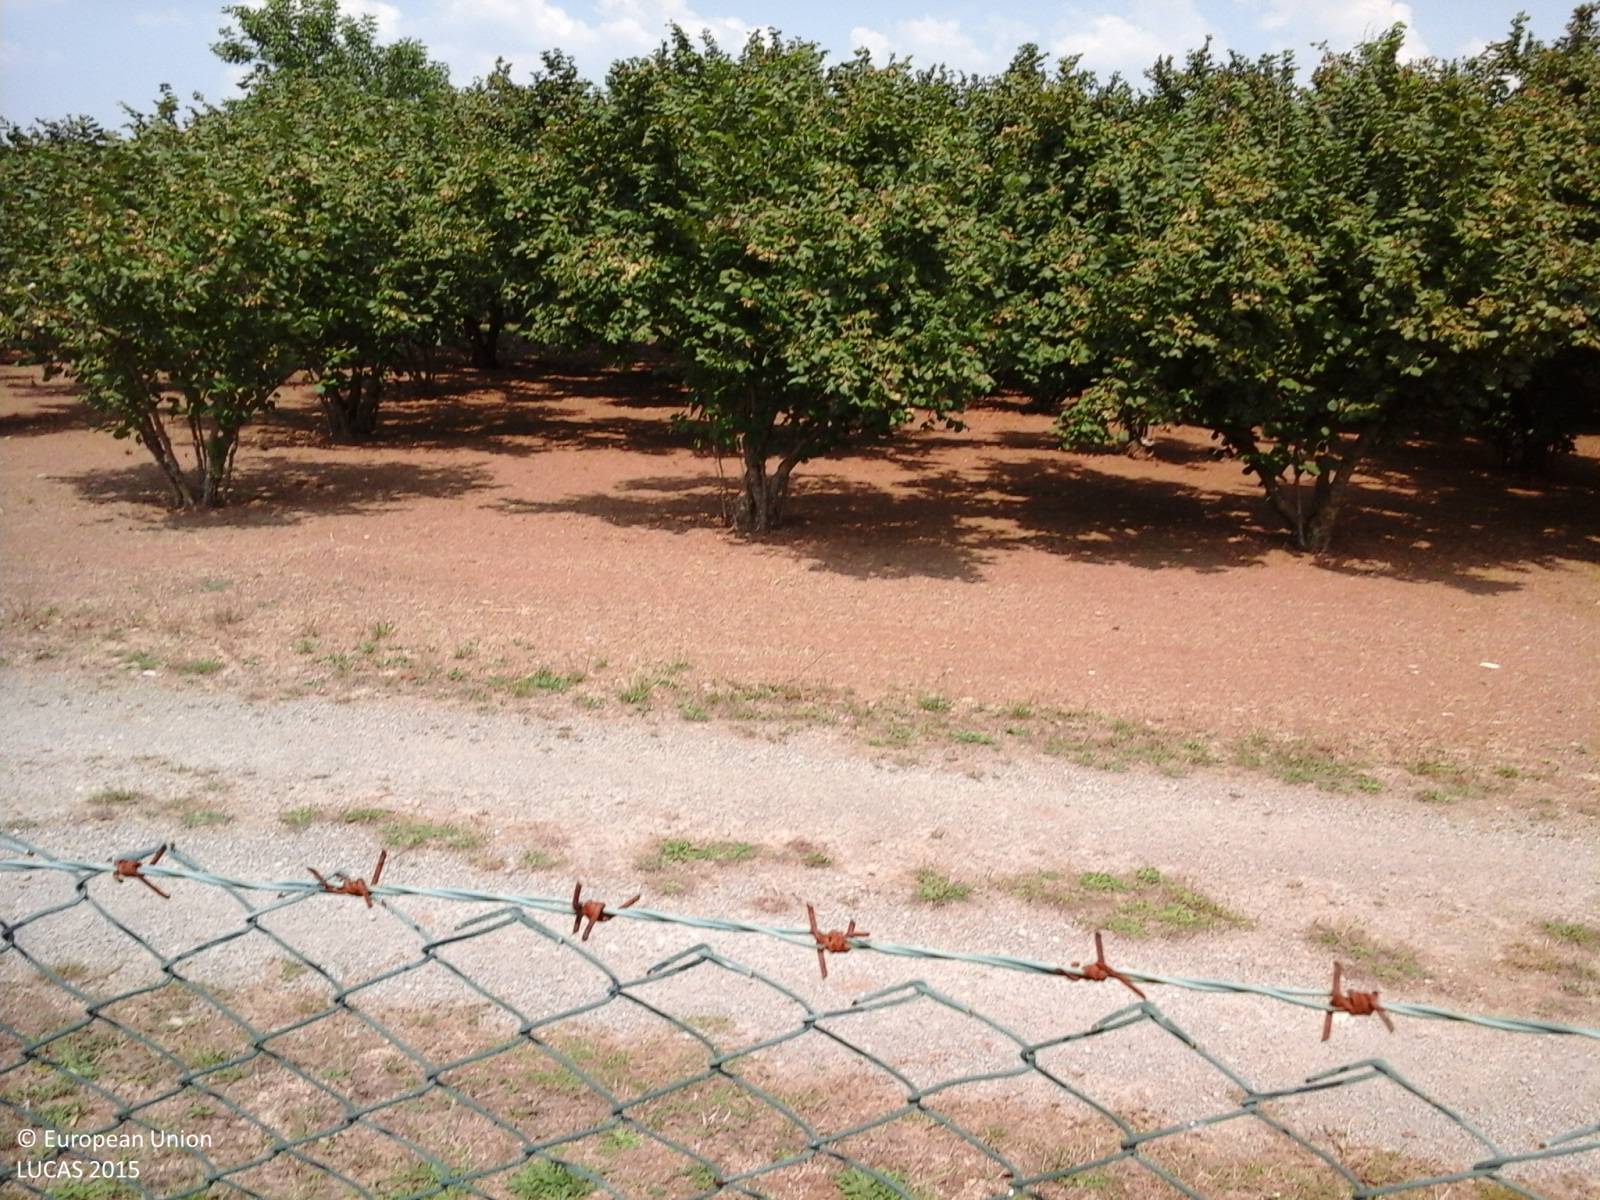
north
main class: Cropland
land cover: Nuts trees
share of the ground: > 75 %
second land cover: Other bare soil
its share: > 75 %
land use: Agriculture (excluding fallow land and kitchen gardens)
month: August
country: IT
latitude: 42.2334
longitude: 12.1613
